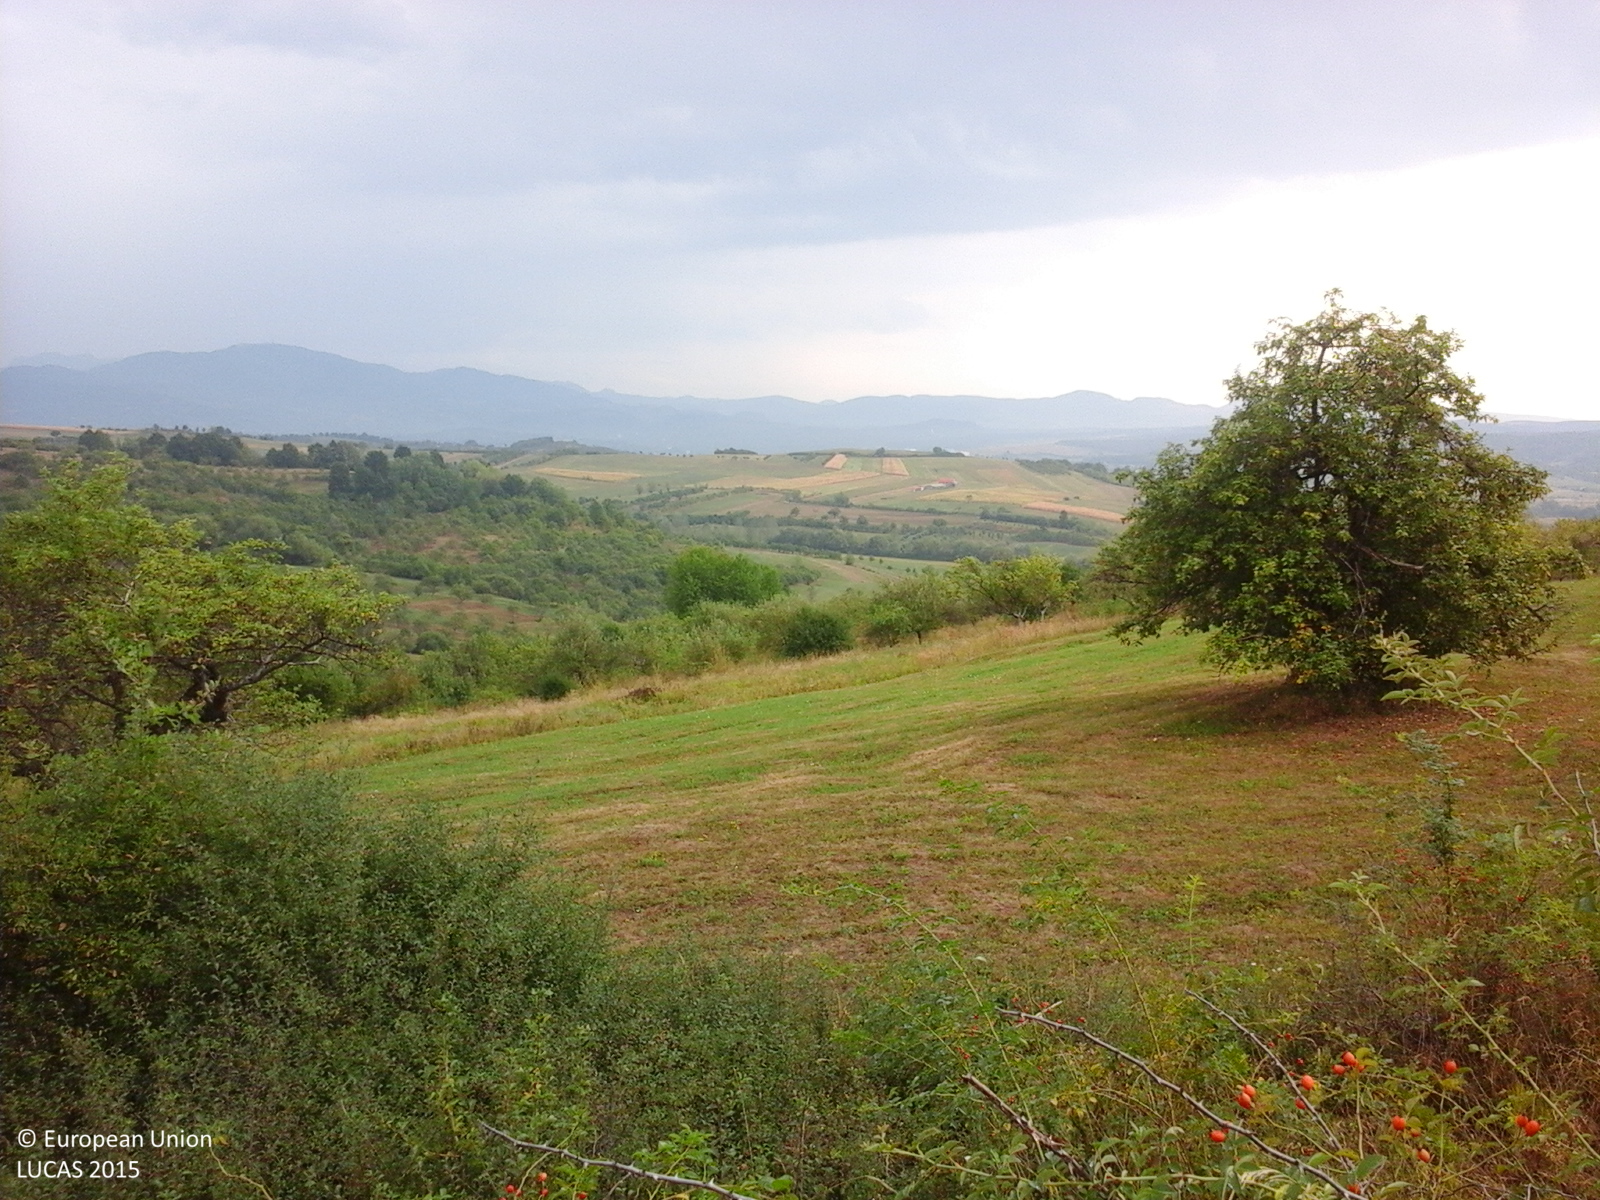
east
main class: Shrubland
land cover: Shrubland without tree cover
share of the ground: > 75 %
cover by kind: shrubs 100 %
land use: Fallow land
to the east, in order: Shrubland without tree cover; Grassland without tree/shrub cover; Spontaneously vegetated surfaces; Apple fruit; Shrubland with sparse tree cover
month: September
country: RO
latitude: 47.5946
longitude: 23.6014
